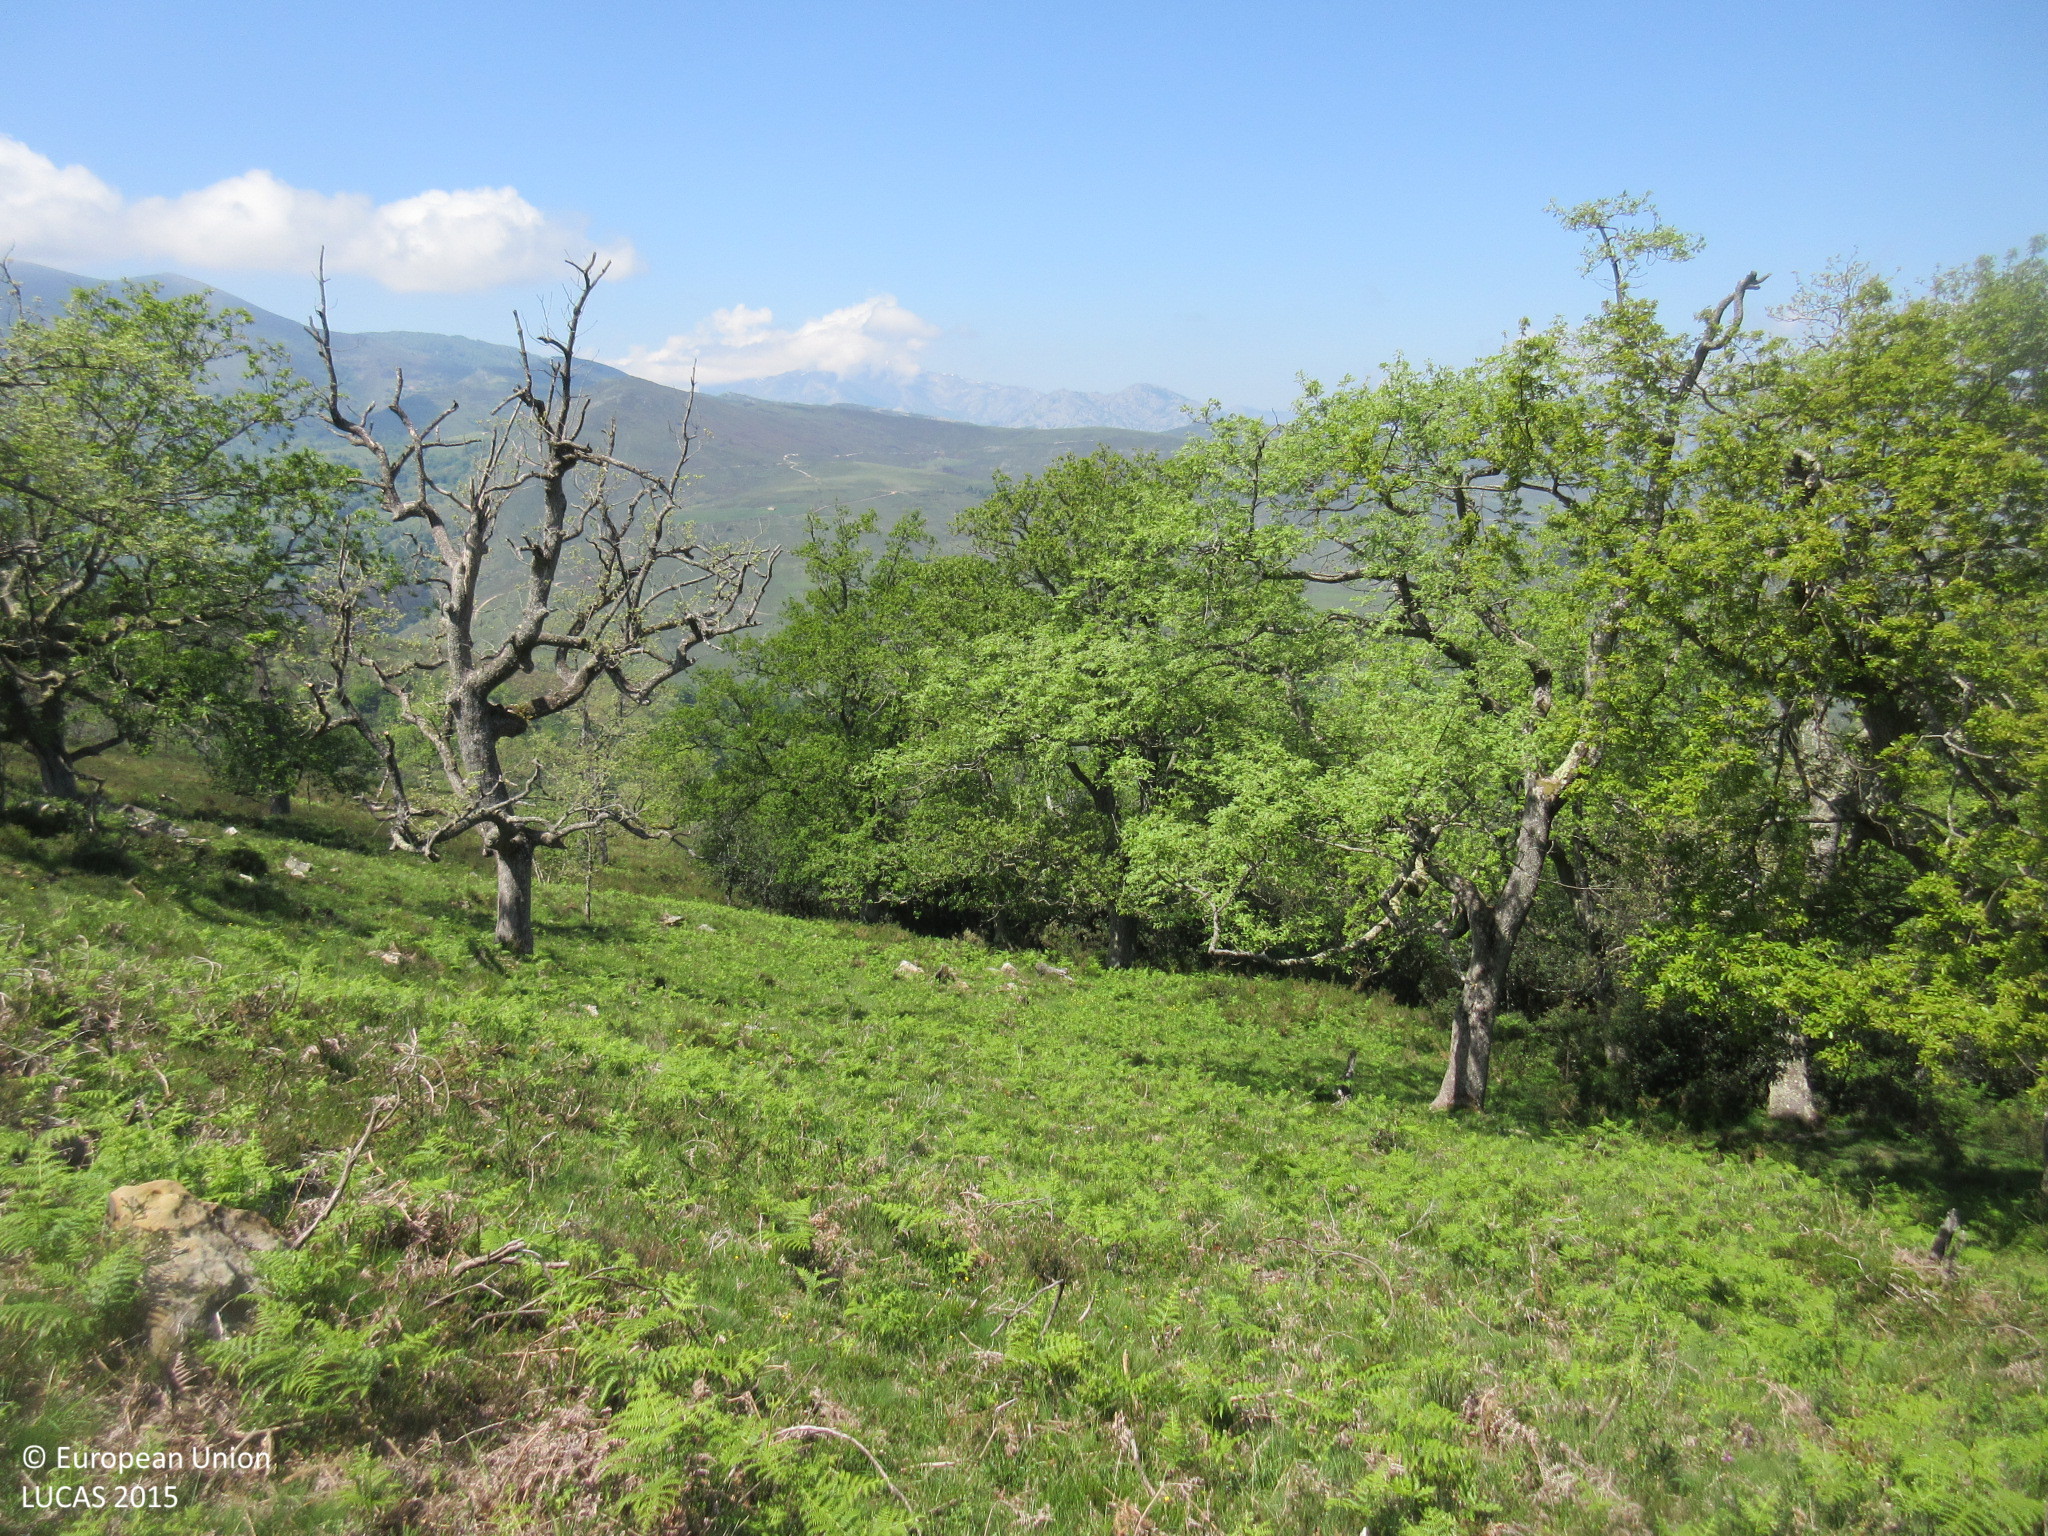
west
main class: Shrubland
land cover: Shrubland without tree cover
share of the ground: 50 - 75 %
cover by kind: shrubs 60 %, herbaceous plants 40 %
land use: Agriculture (excluding fallow land and kitchen gardens)
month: May
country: ES
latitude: 43.2231
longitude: -4.4499
